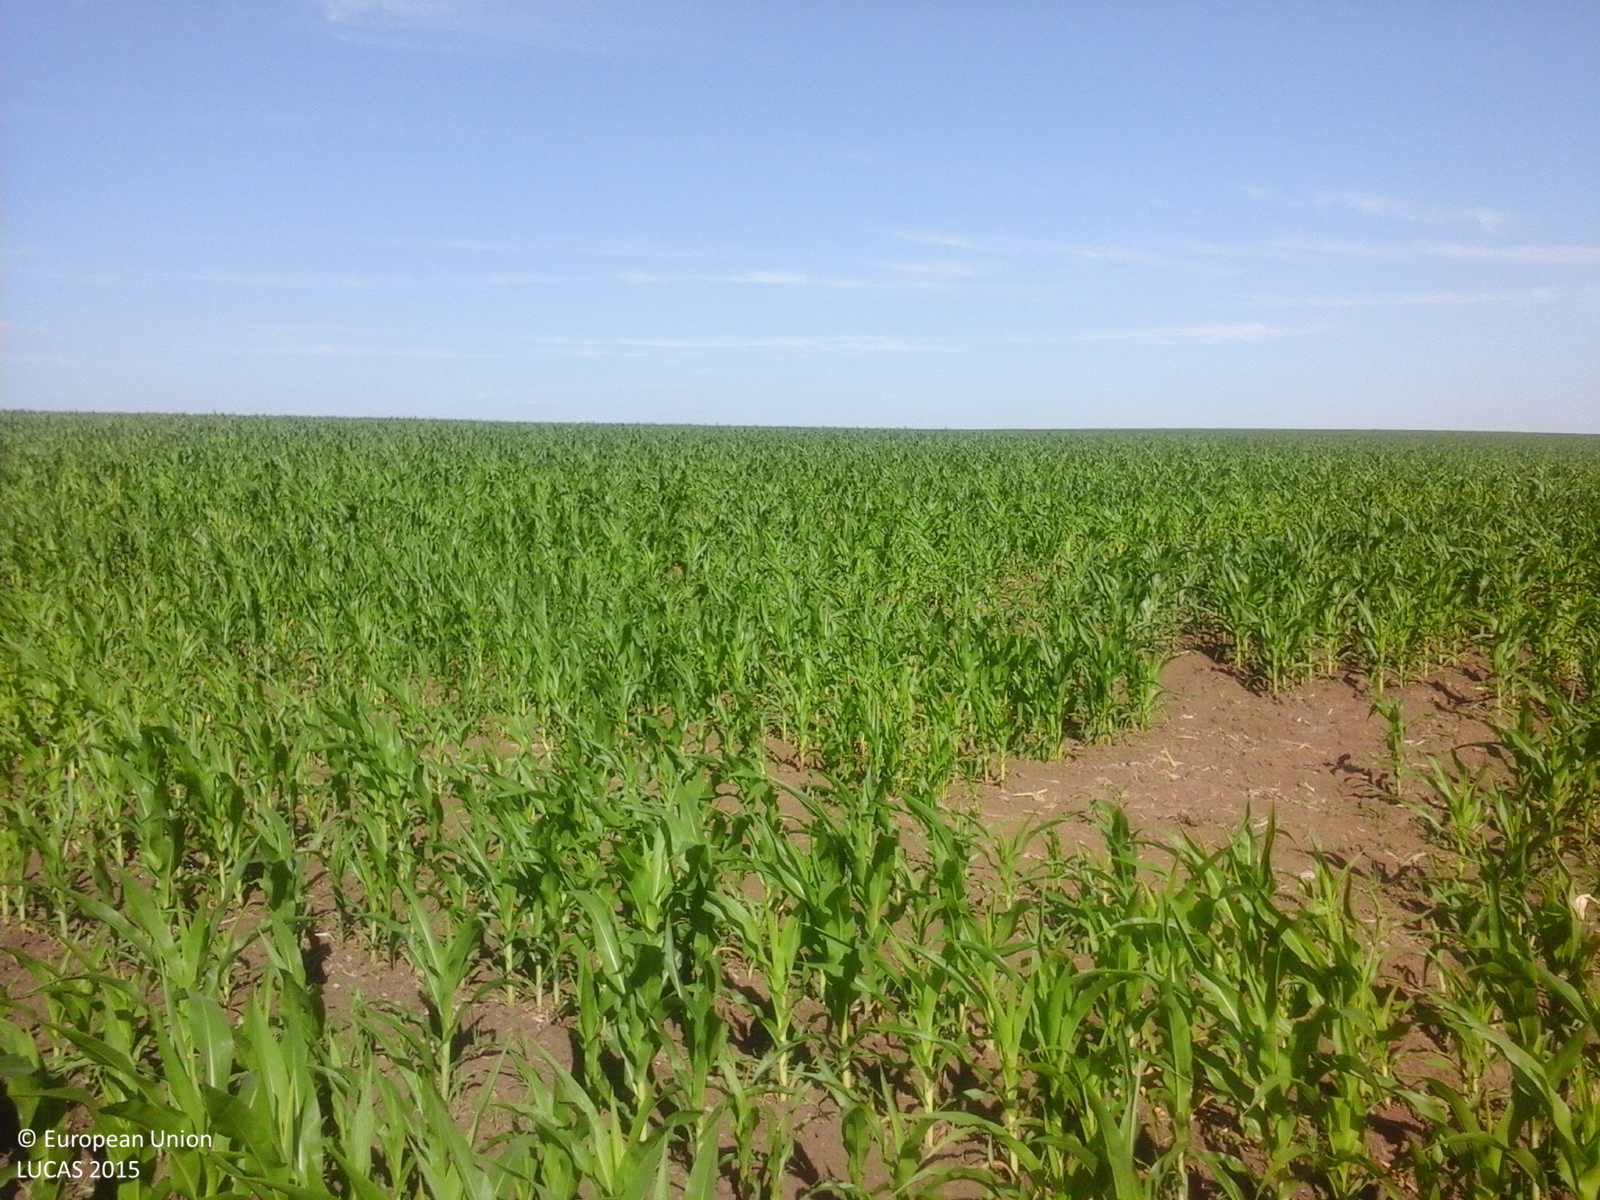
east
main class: Cropland
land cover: Maize
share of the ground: 50 - 75 %
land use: Agriculture (excluding fallow land and kitchen gardens)
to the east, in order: Maize
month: June
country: RO
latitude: 47.8806
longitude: 27.1320
